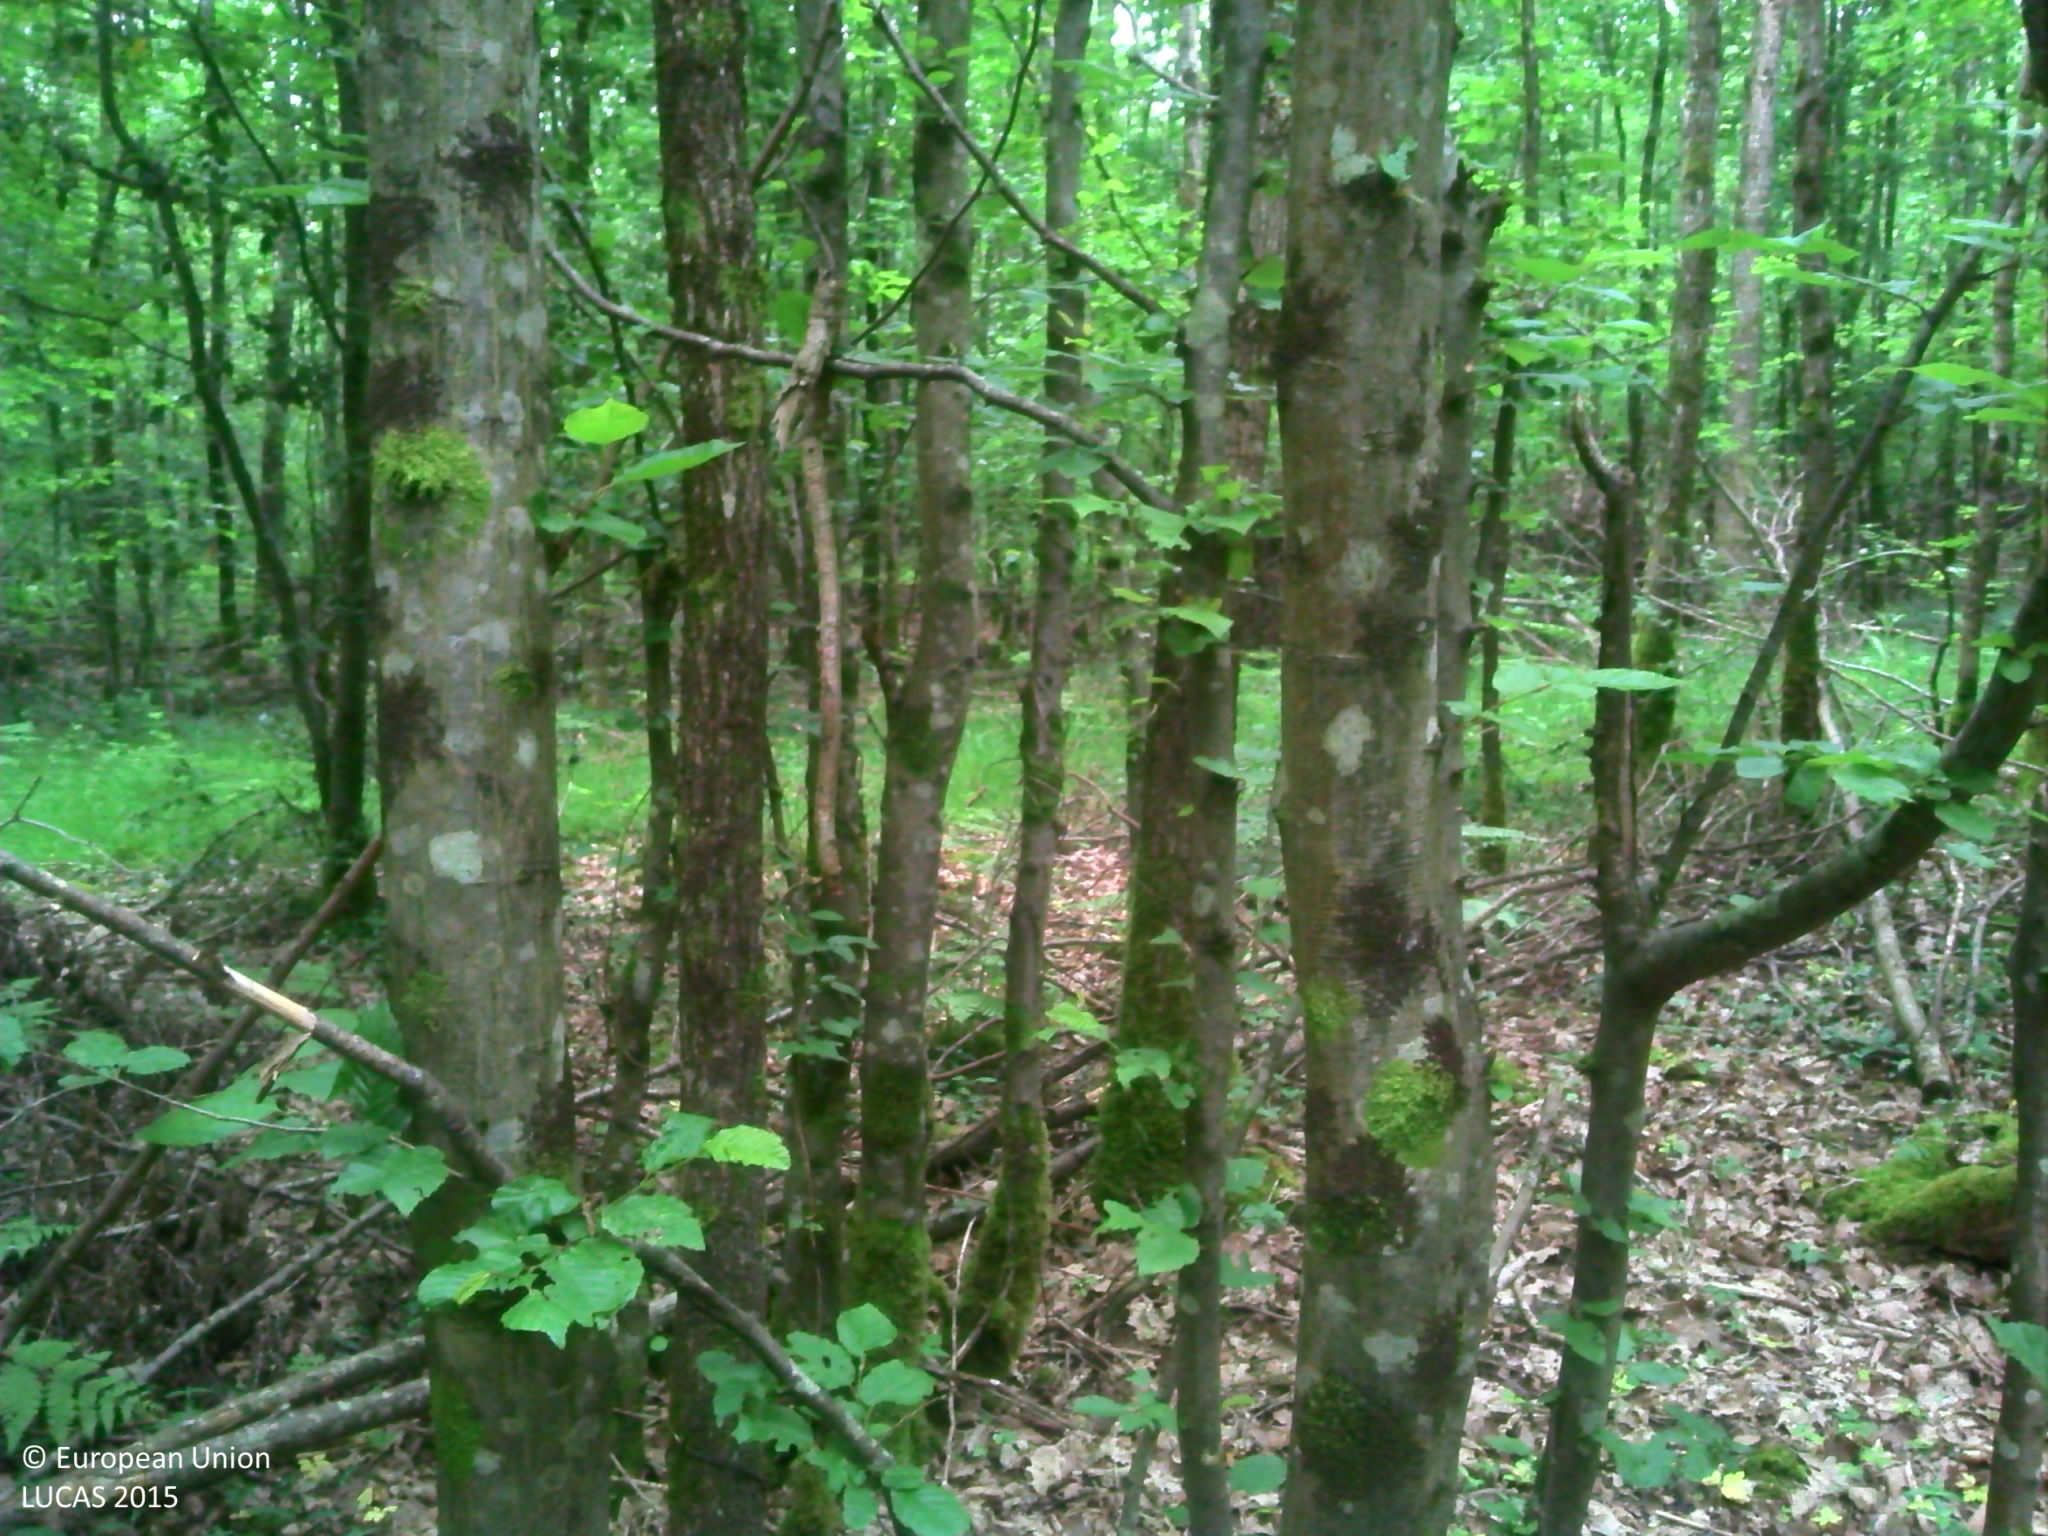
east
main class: Woodland
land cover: Broadleaved woodland
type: mesophytic deciduous forest
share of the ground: > 75 %
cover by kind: broadleaved forest trees 90 %, herbaceous plants 10 %
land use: Forestry
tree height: > 5 m
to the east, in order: Broadleaved woodland; Tracks; Broadleaved woodland; Tracks; Broadleaved woodland; Tracks; Broadleaved woodland; Tracks; Broadleaved woodland; Tracks; Broadleaved woodland; Tracks; Broadleaved woodland; Ditches and canals; Broadleaved woodland
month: June
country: FR
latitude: 48.5379
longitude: 4.8921
